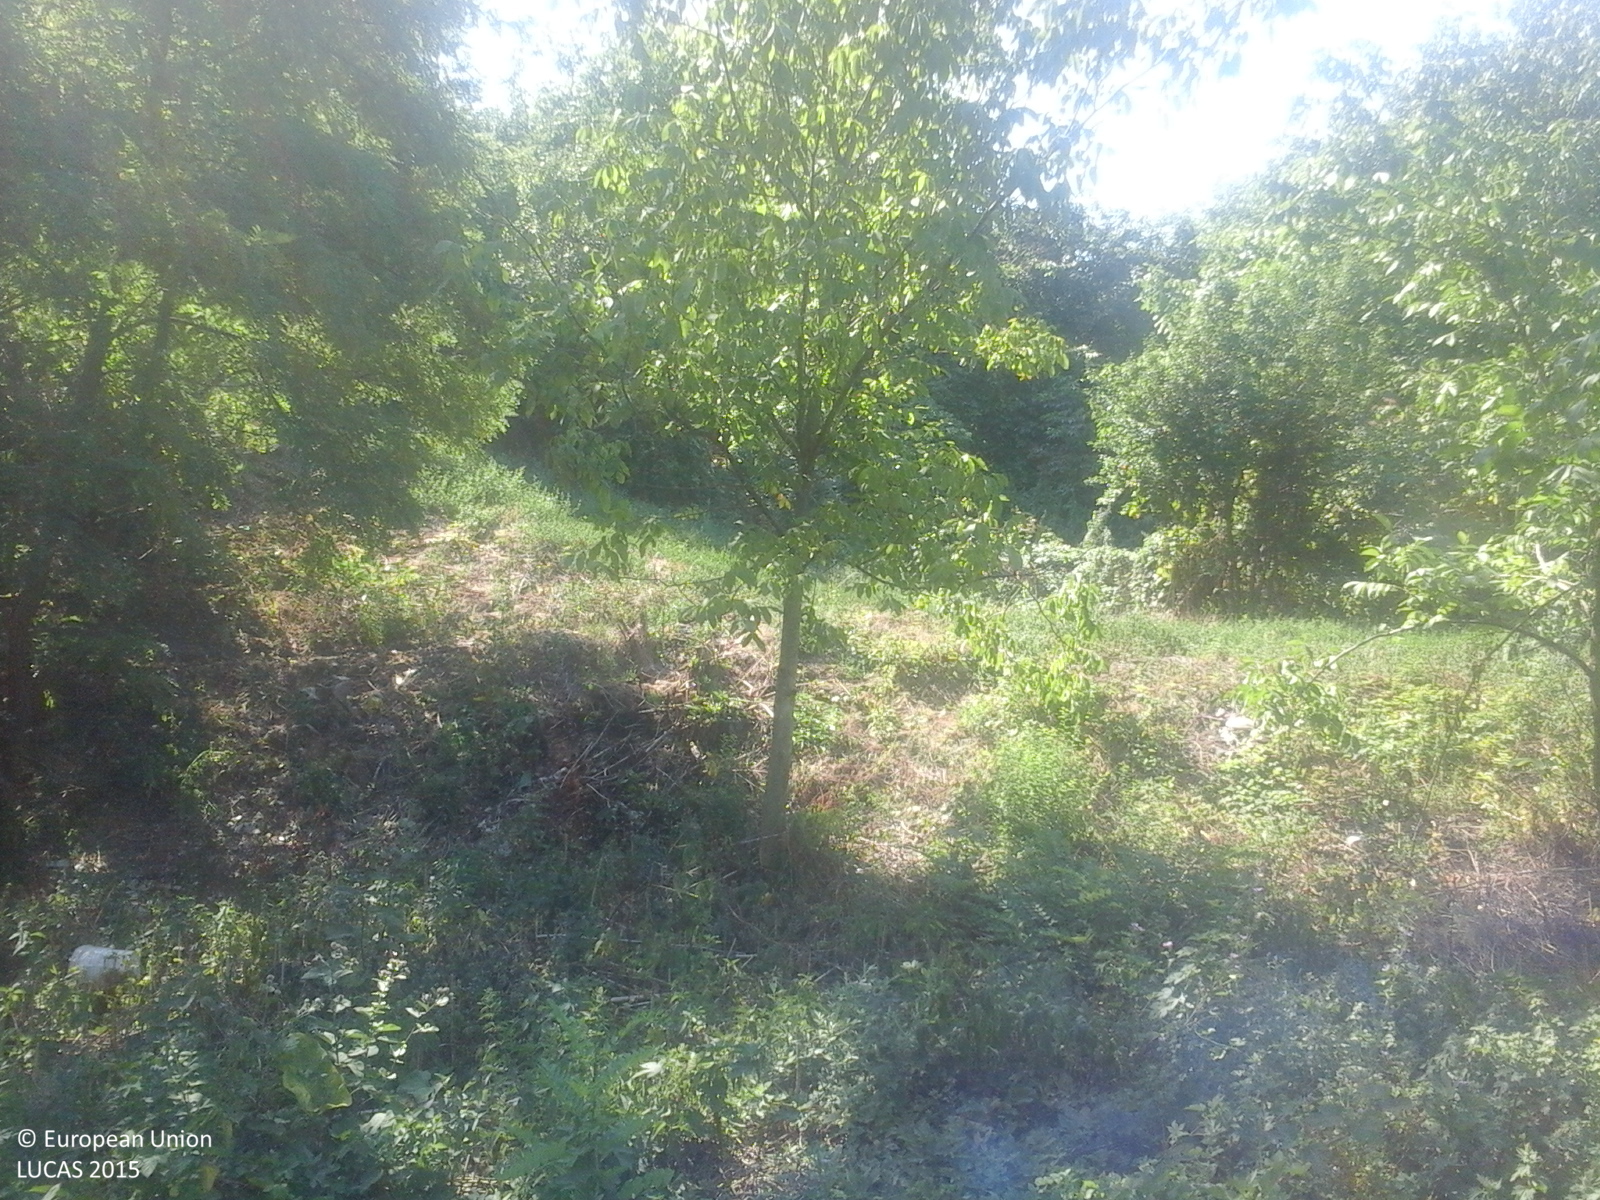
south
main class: Woodland
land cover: Broadleaved woodland
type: exotic forest
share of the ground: > 75 %
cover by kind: broadleaved forest trees 100 %
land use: Forestry
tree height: > 5 m
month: July
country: RO
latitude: 46.6793
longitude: 28.0530
